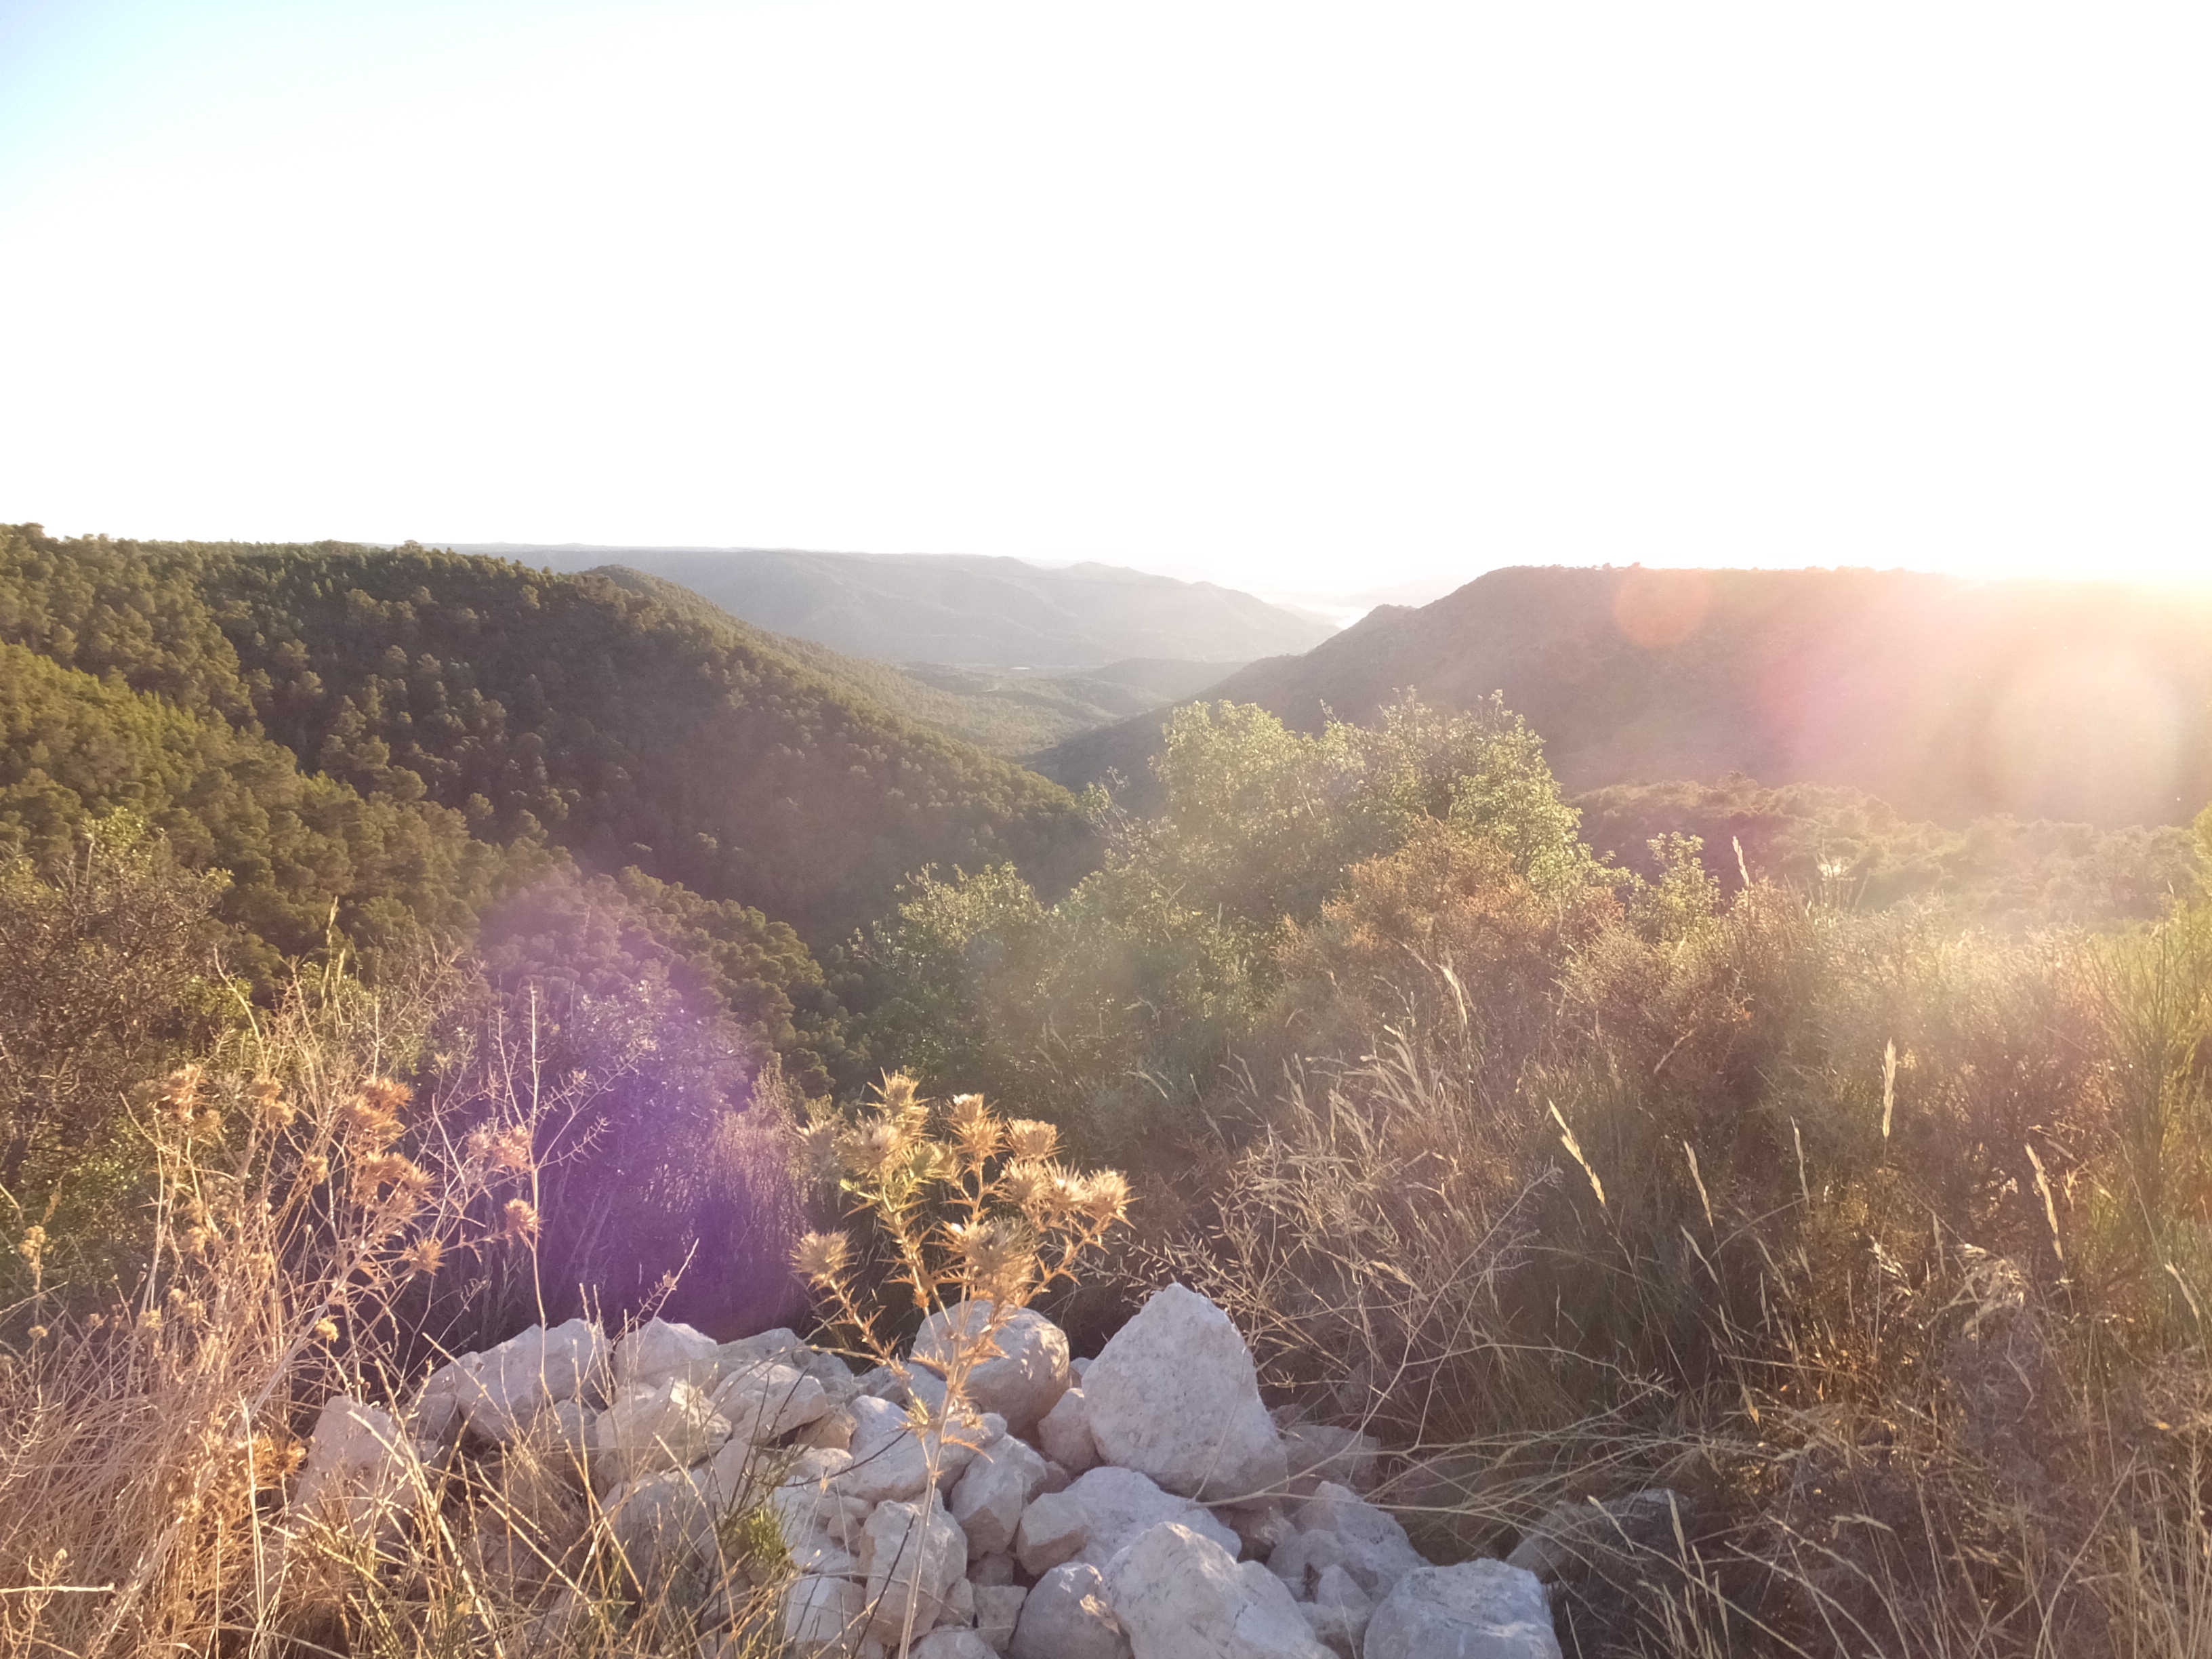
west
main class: Shrubland
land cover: Shrubland with sparse tree cover
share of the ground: > 75 %
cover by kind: shrubs 70 %, herbaceous plants 25 %, coniferous forest trees 5 %
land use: Semi-natural and natural areas not in use
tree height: < 5 m
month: July
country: ES
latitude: 41.4019
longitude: 0.2630
